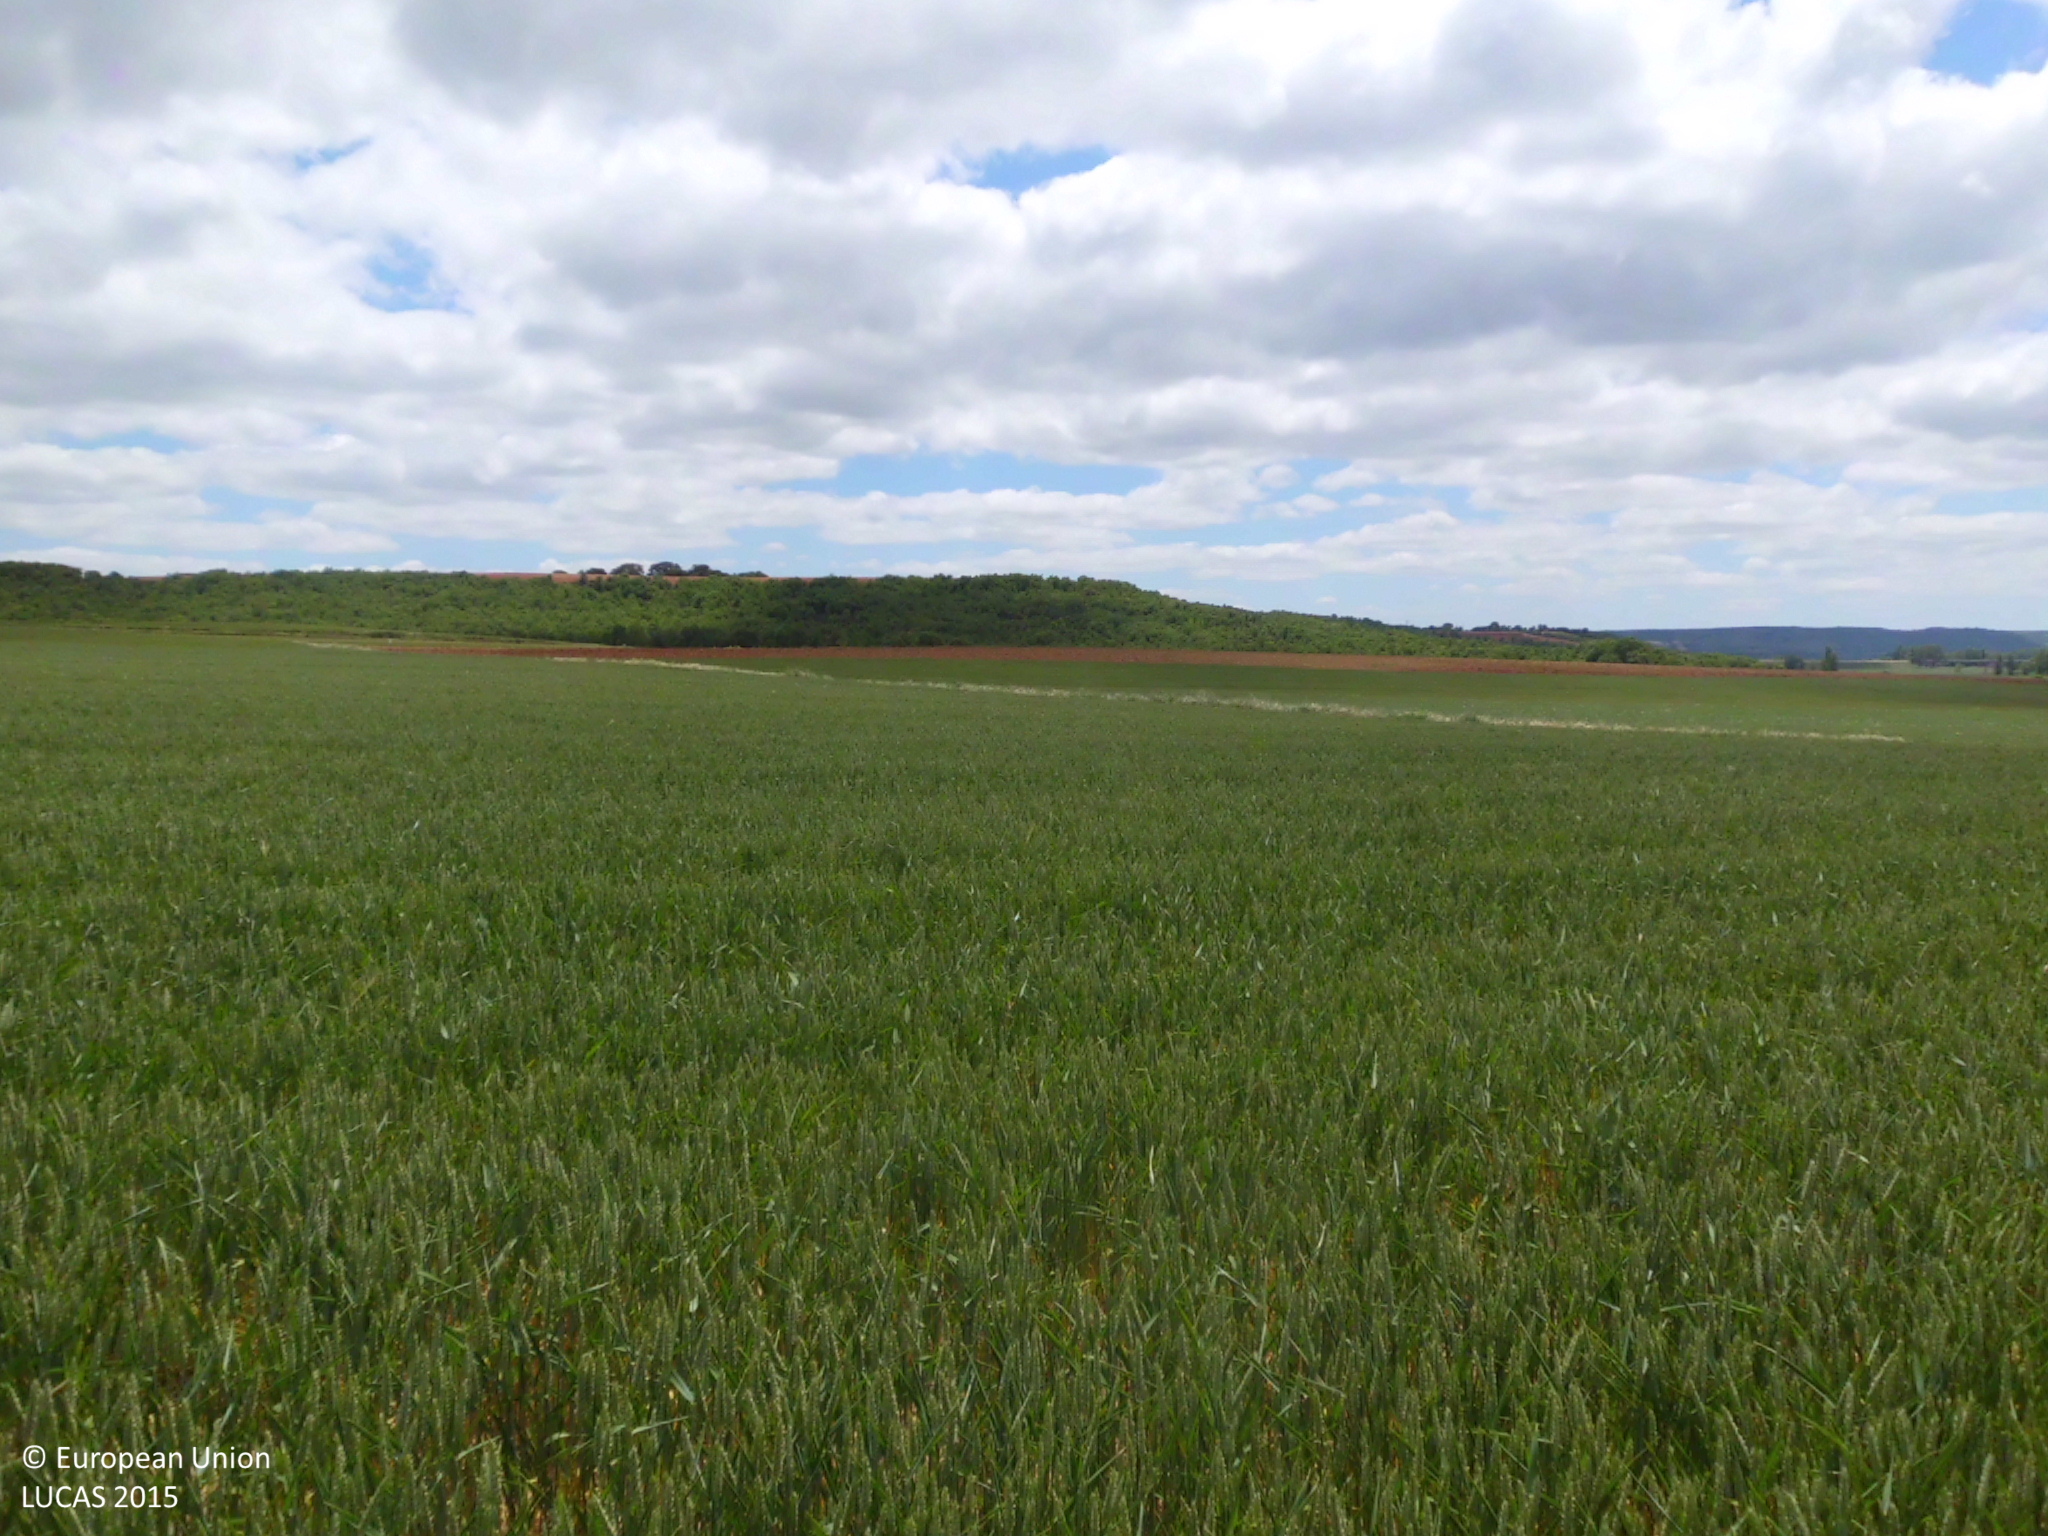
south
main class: Cropland
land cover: Common wheat
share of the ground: > 75 %
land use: Agriculture (excluding fallow land and kitchen gardens)
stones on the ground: 25 - 50 %
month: May
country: ES
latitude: 42.2939
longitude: -3.9020
